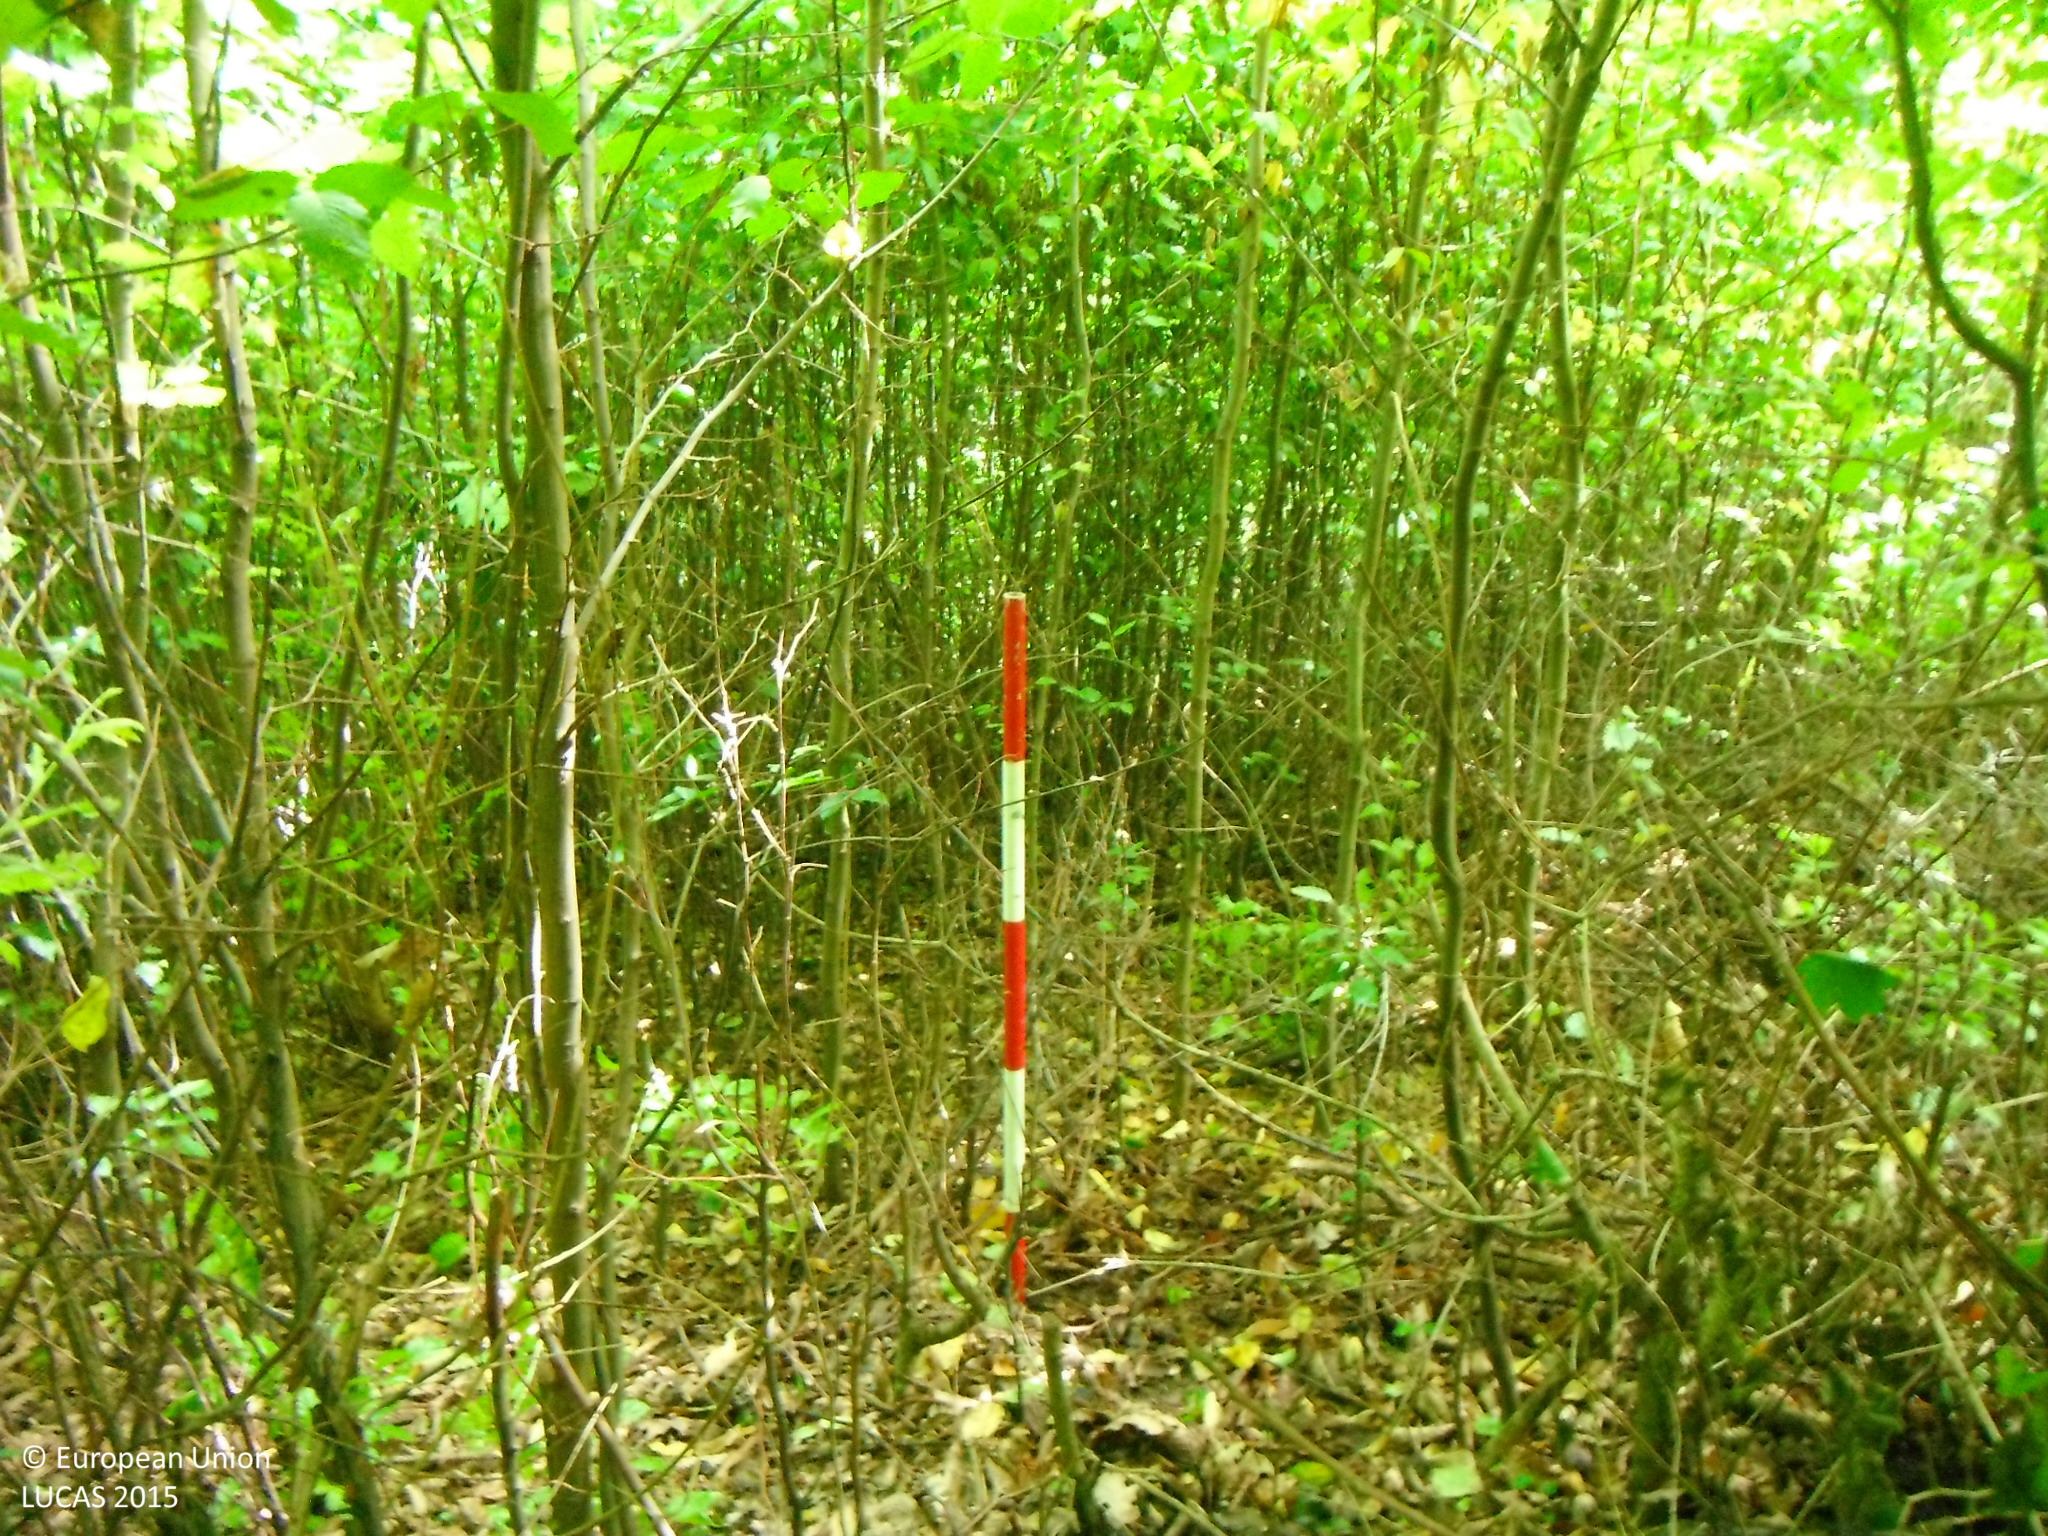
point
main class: Woodland
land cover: Broadleaved woodland
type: mesophytic deciduous forest
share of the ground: > 75 %
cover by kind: broadleaved forest trees 100 %
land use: Forestry
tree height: > 5 m
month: June
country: SK
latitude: 48.2123
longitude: 19.4847
